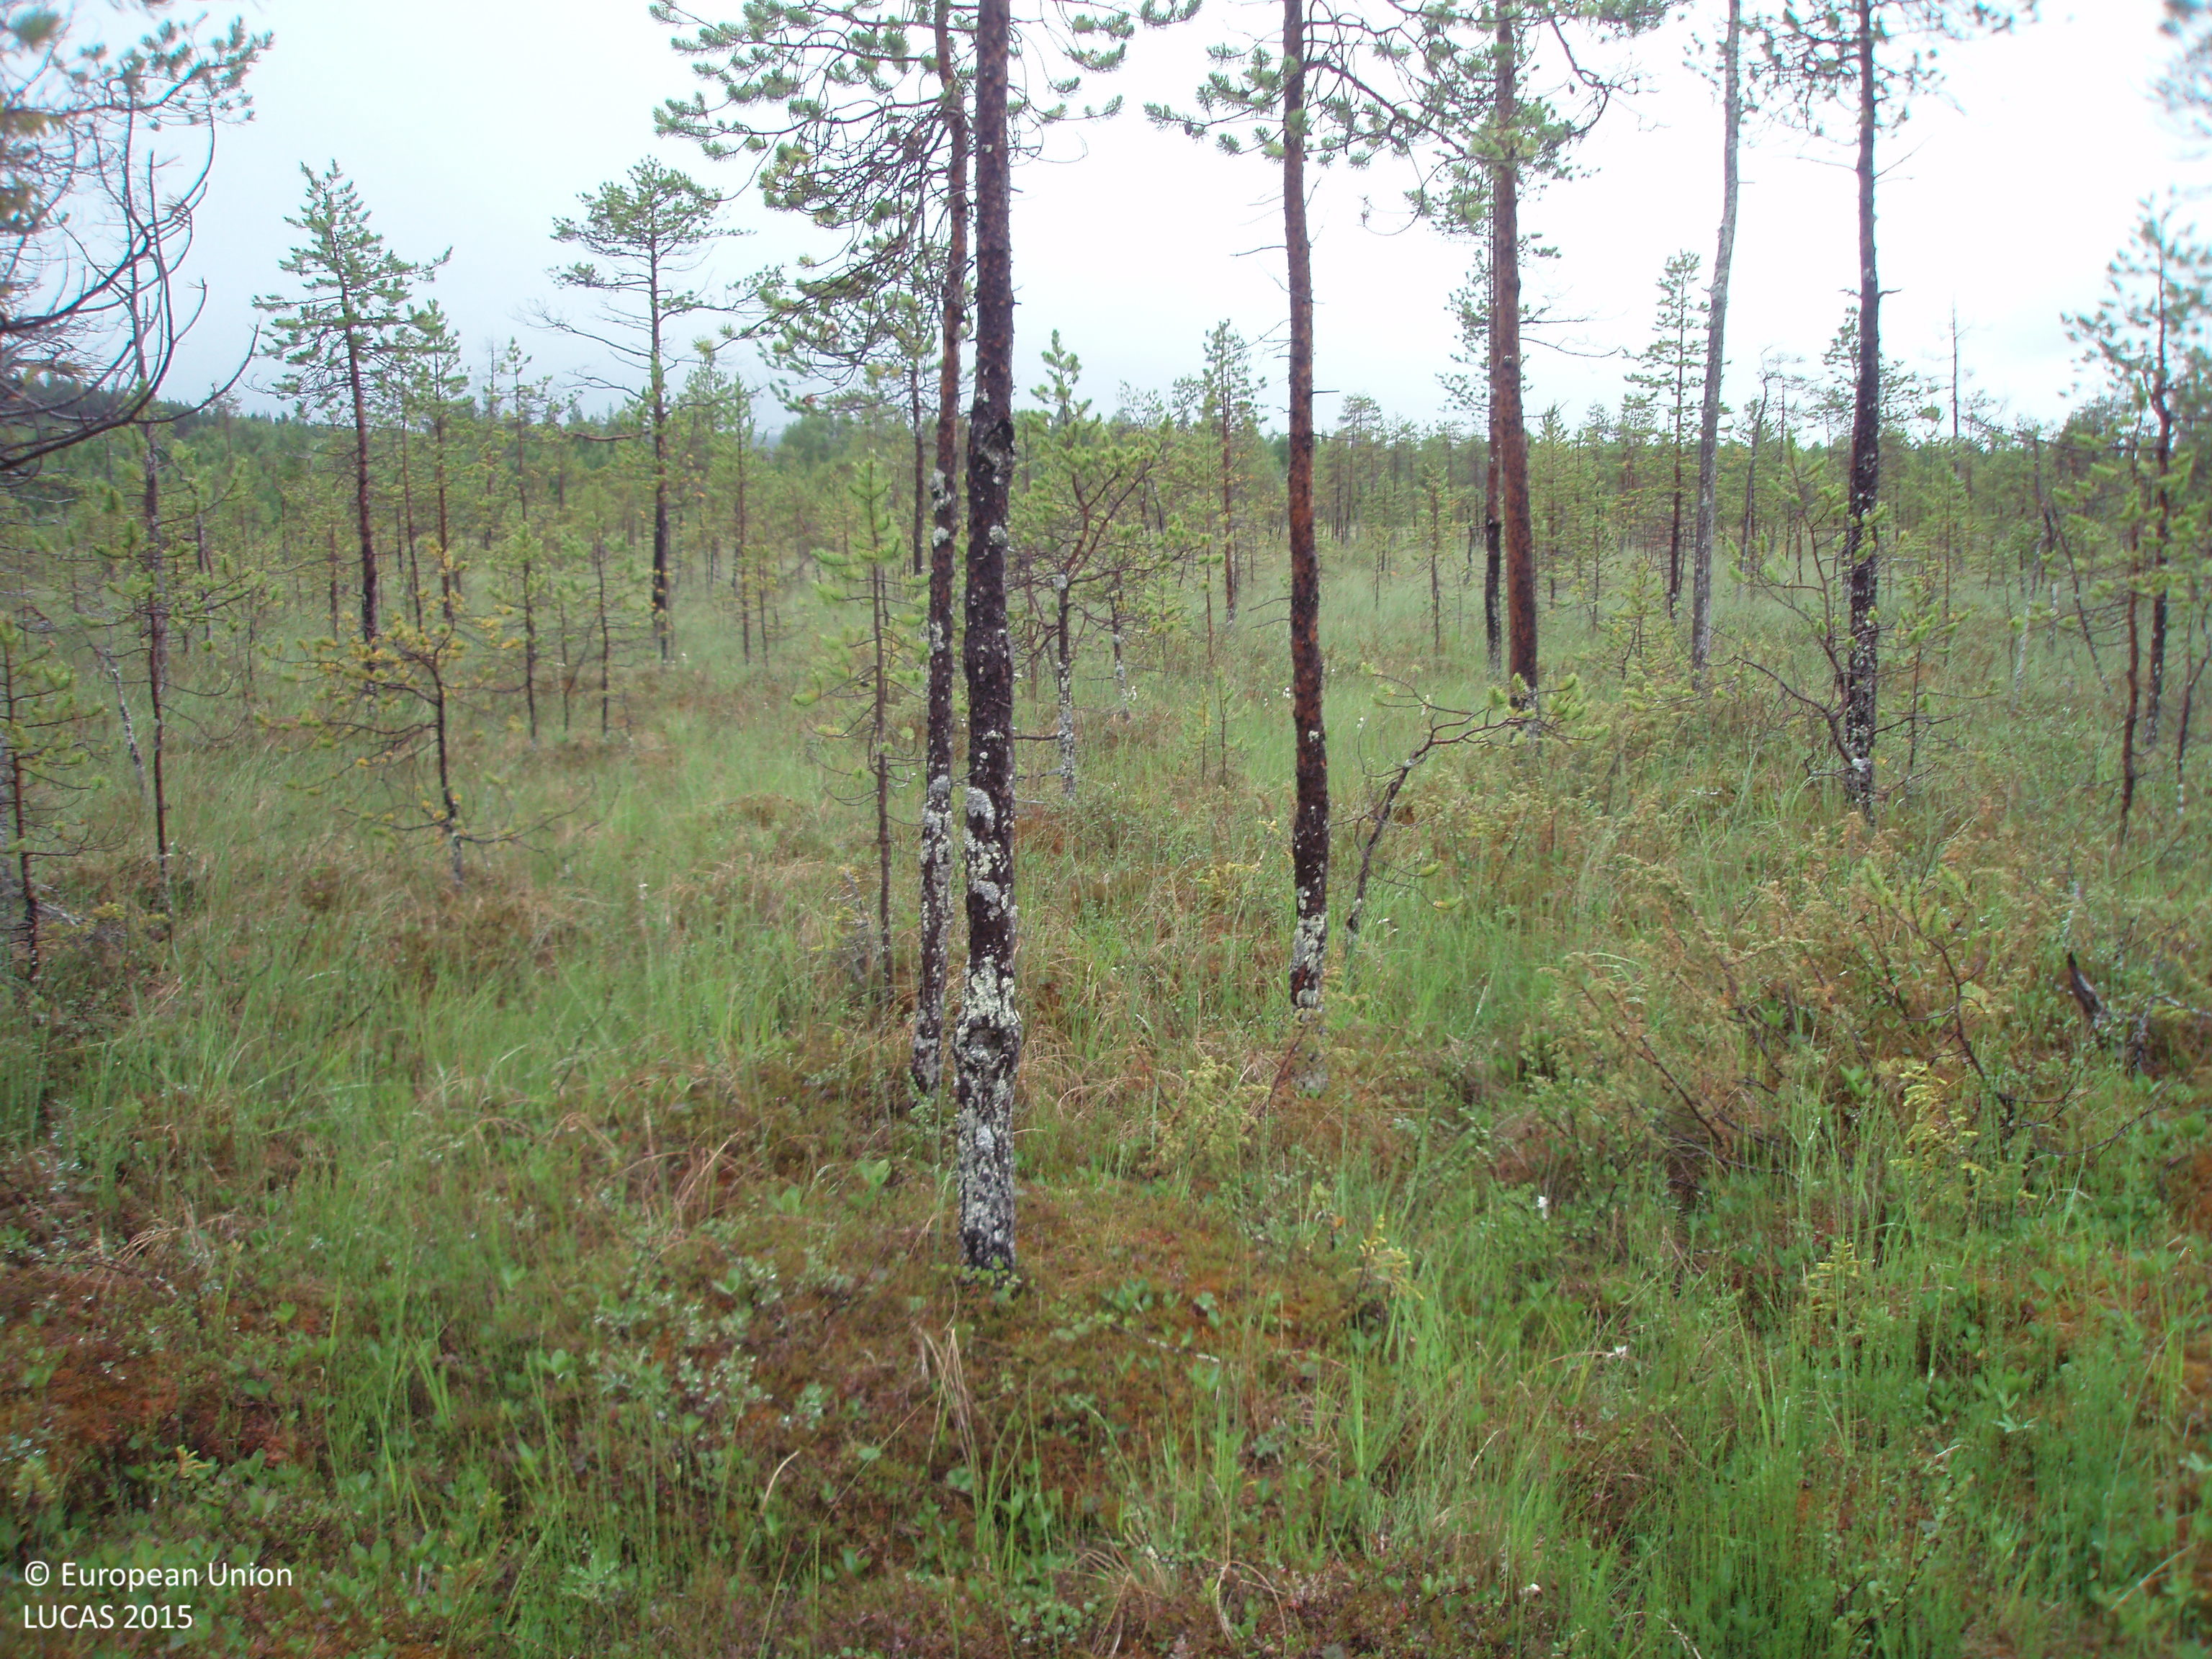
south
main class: Woodland
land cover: Pine dominated coniferous woodland
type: mire and swamp forests
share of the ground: 10 - 25 %
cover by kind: shrubs 45 %, lichens and mosses 35 %, coniferous forest trees 10 %, herbaceous plants 10 %
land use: Semi-natural and natural areas not in use
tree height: > 5 m
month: July
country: FI
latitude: 66.7888
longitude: 28.5369
